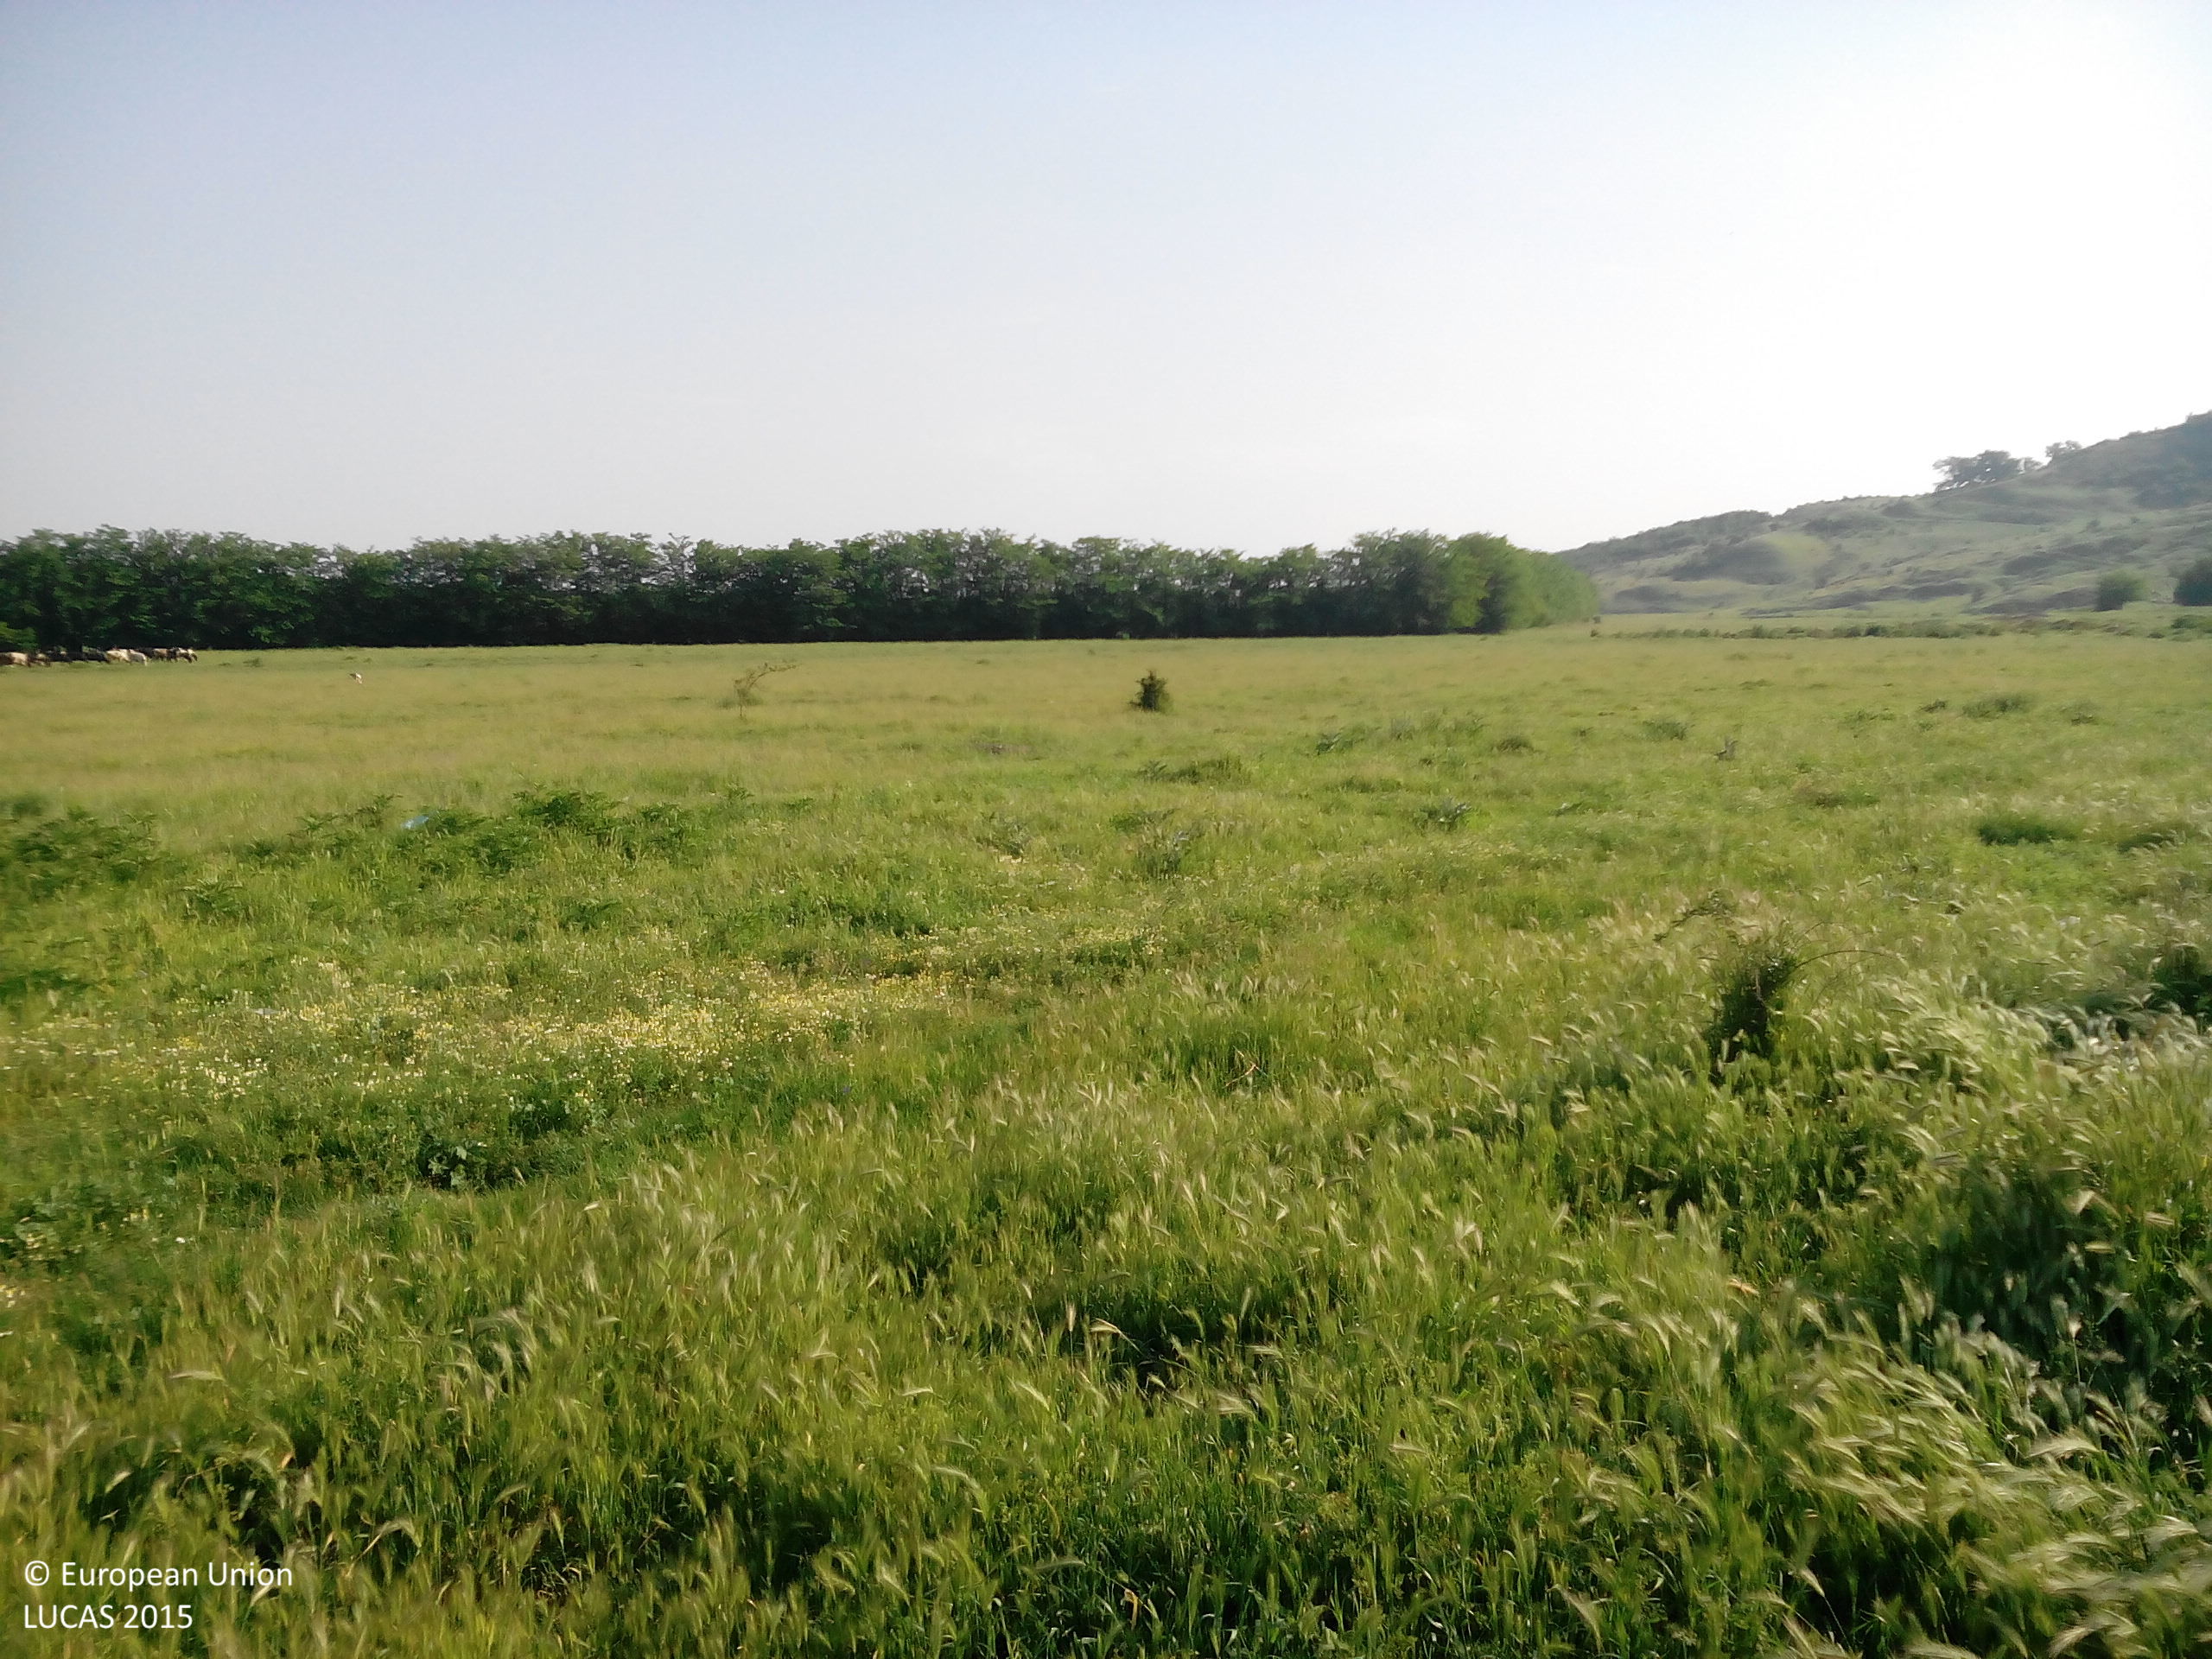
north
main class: Cropland
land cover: Lucerne
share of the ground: > 75 %
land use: Agriculture (excluding fallow land and kitchen gardens)
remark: Harvested field
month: May
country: BG
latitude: 43.5972
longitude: 24.3928
